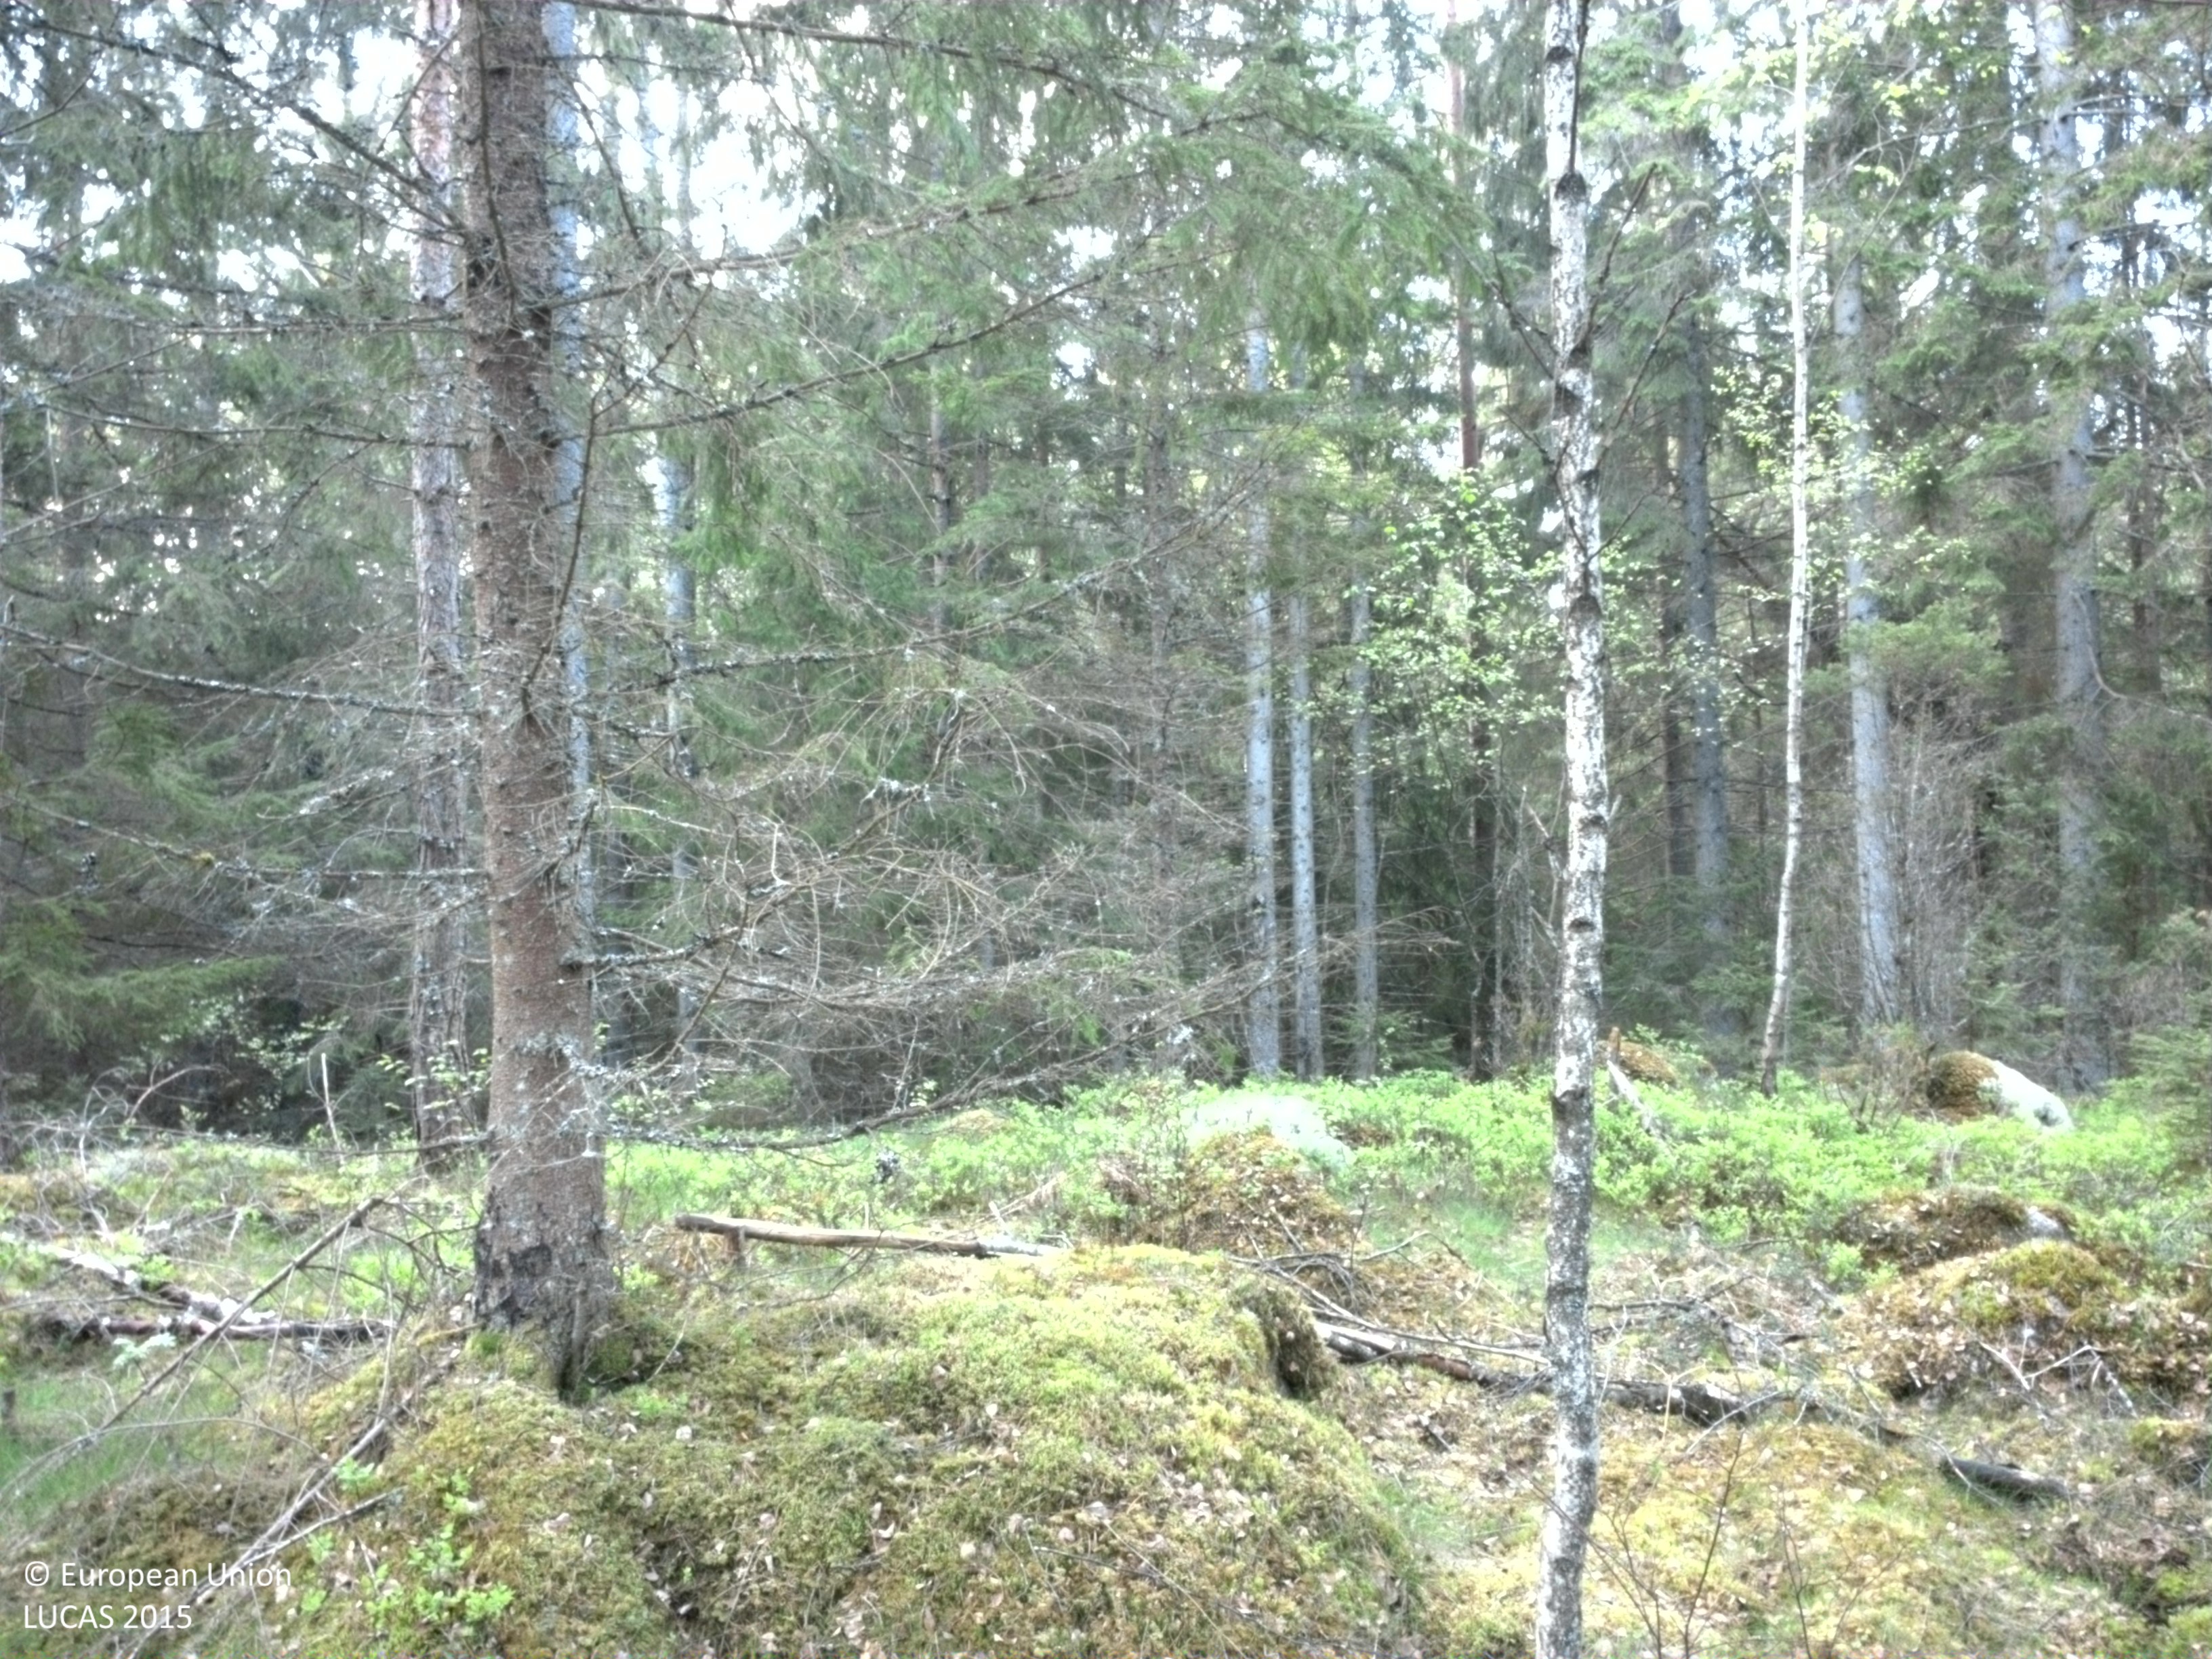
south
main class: Woodland
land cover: Pine dominated coniferous woodland
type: boreal forest
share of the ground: 50 - 75 %
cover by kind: coniferous forest trees 70 %, lichens and mosses 25 %, broadleaved forest trees 5 %
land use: Forestry
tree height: > 5 m
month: May
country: SE
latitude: 56.5567
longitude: 14.5692
